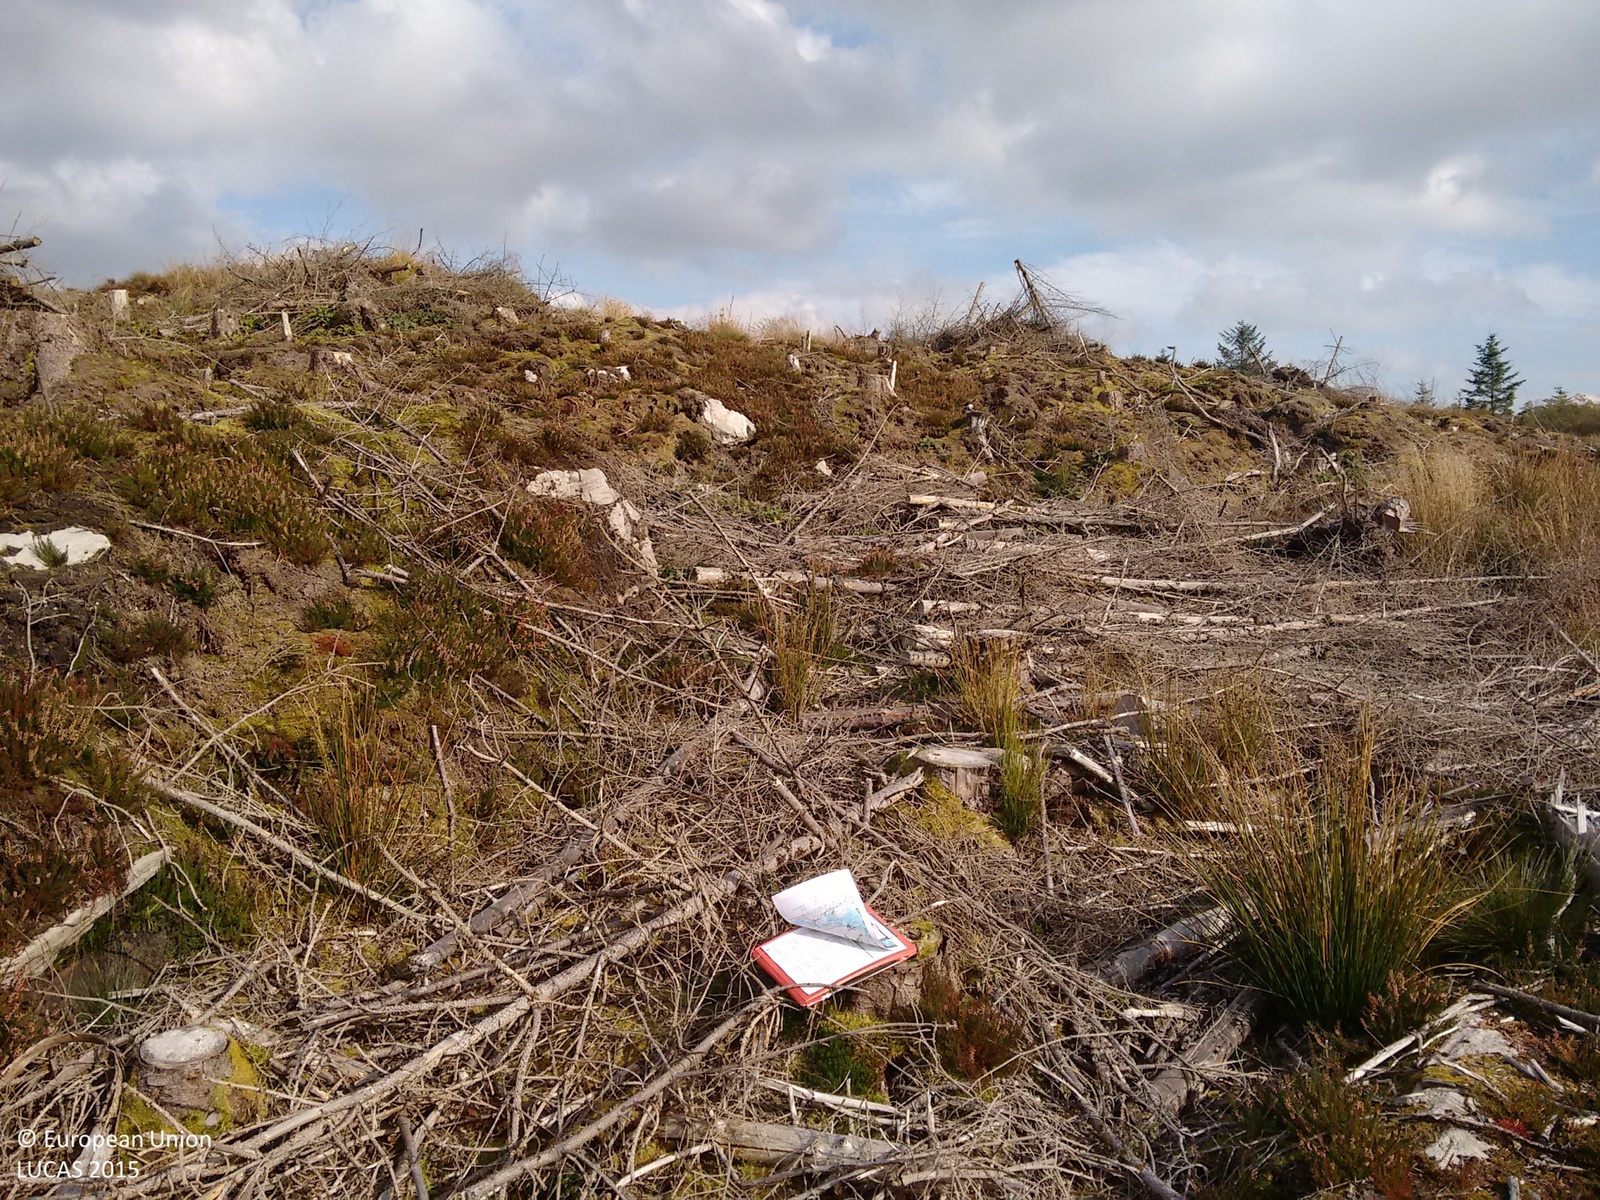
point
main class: Grassland
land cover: Grassland without tree/shrub cover
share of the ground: > 75 %
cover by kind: herbaceous plants 55 %, unconsolidated bare surface 25 %, lichens and mosses 20 %
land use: Forestry
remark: Clear cut
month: October
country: GB
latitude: 54.3222
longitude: -7.8968
